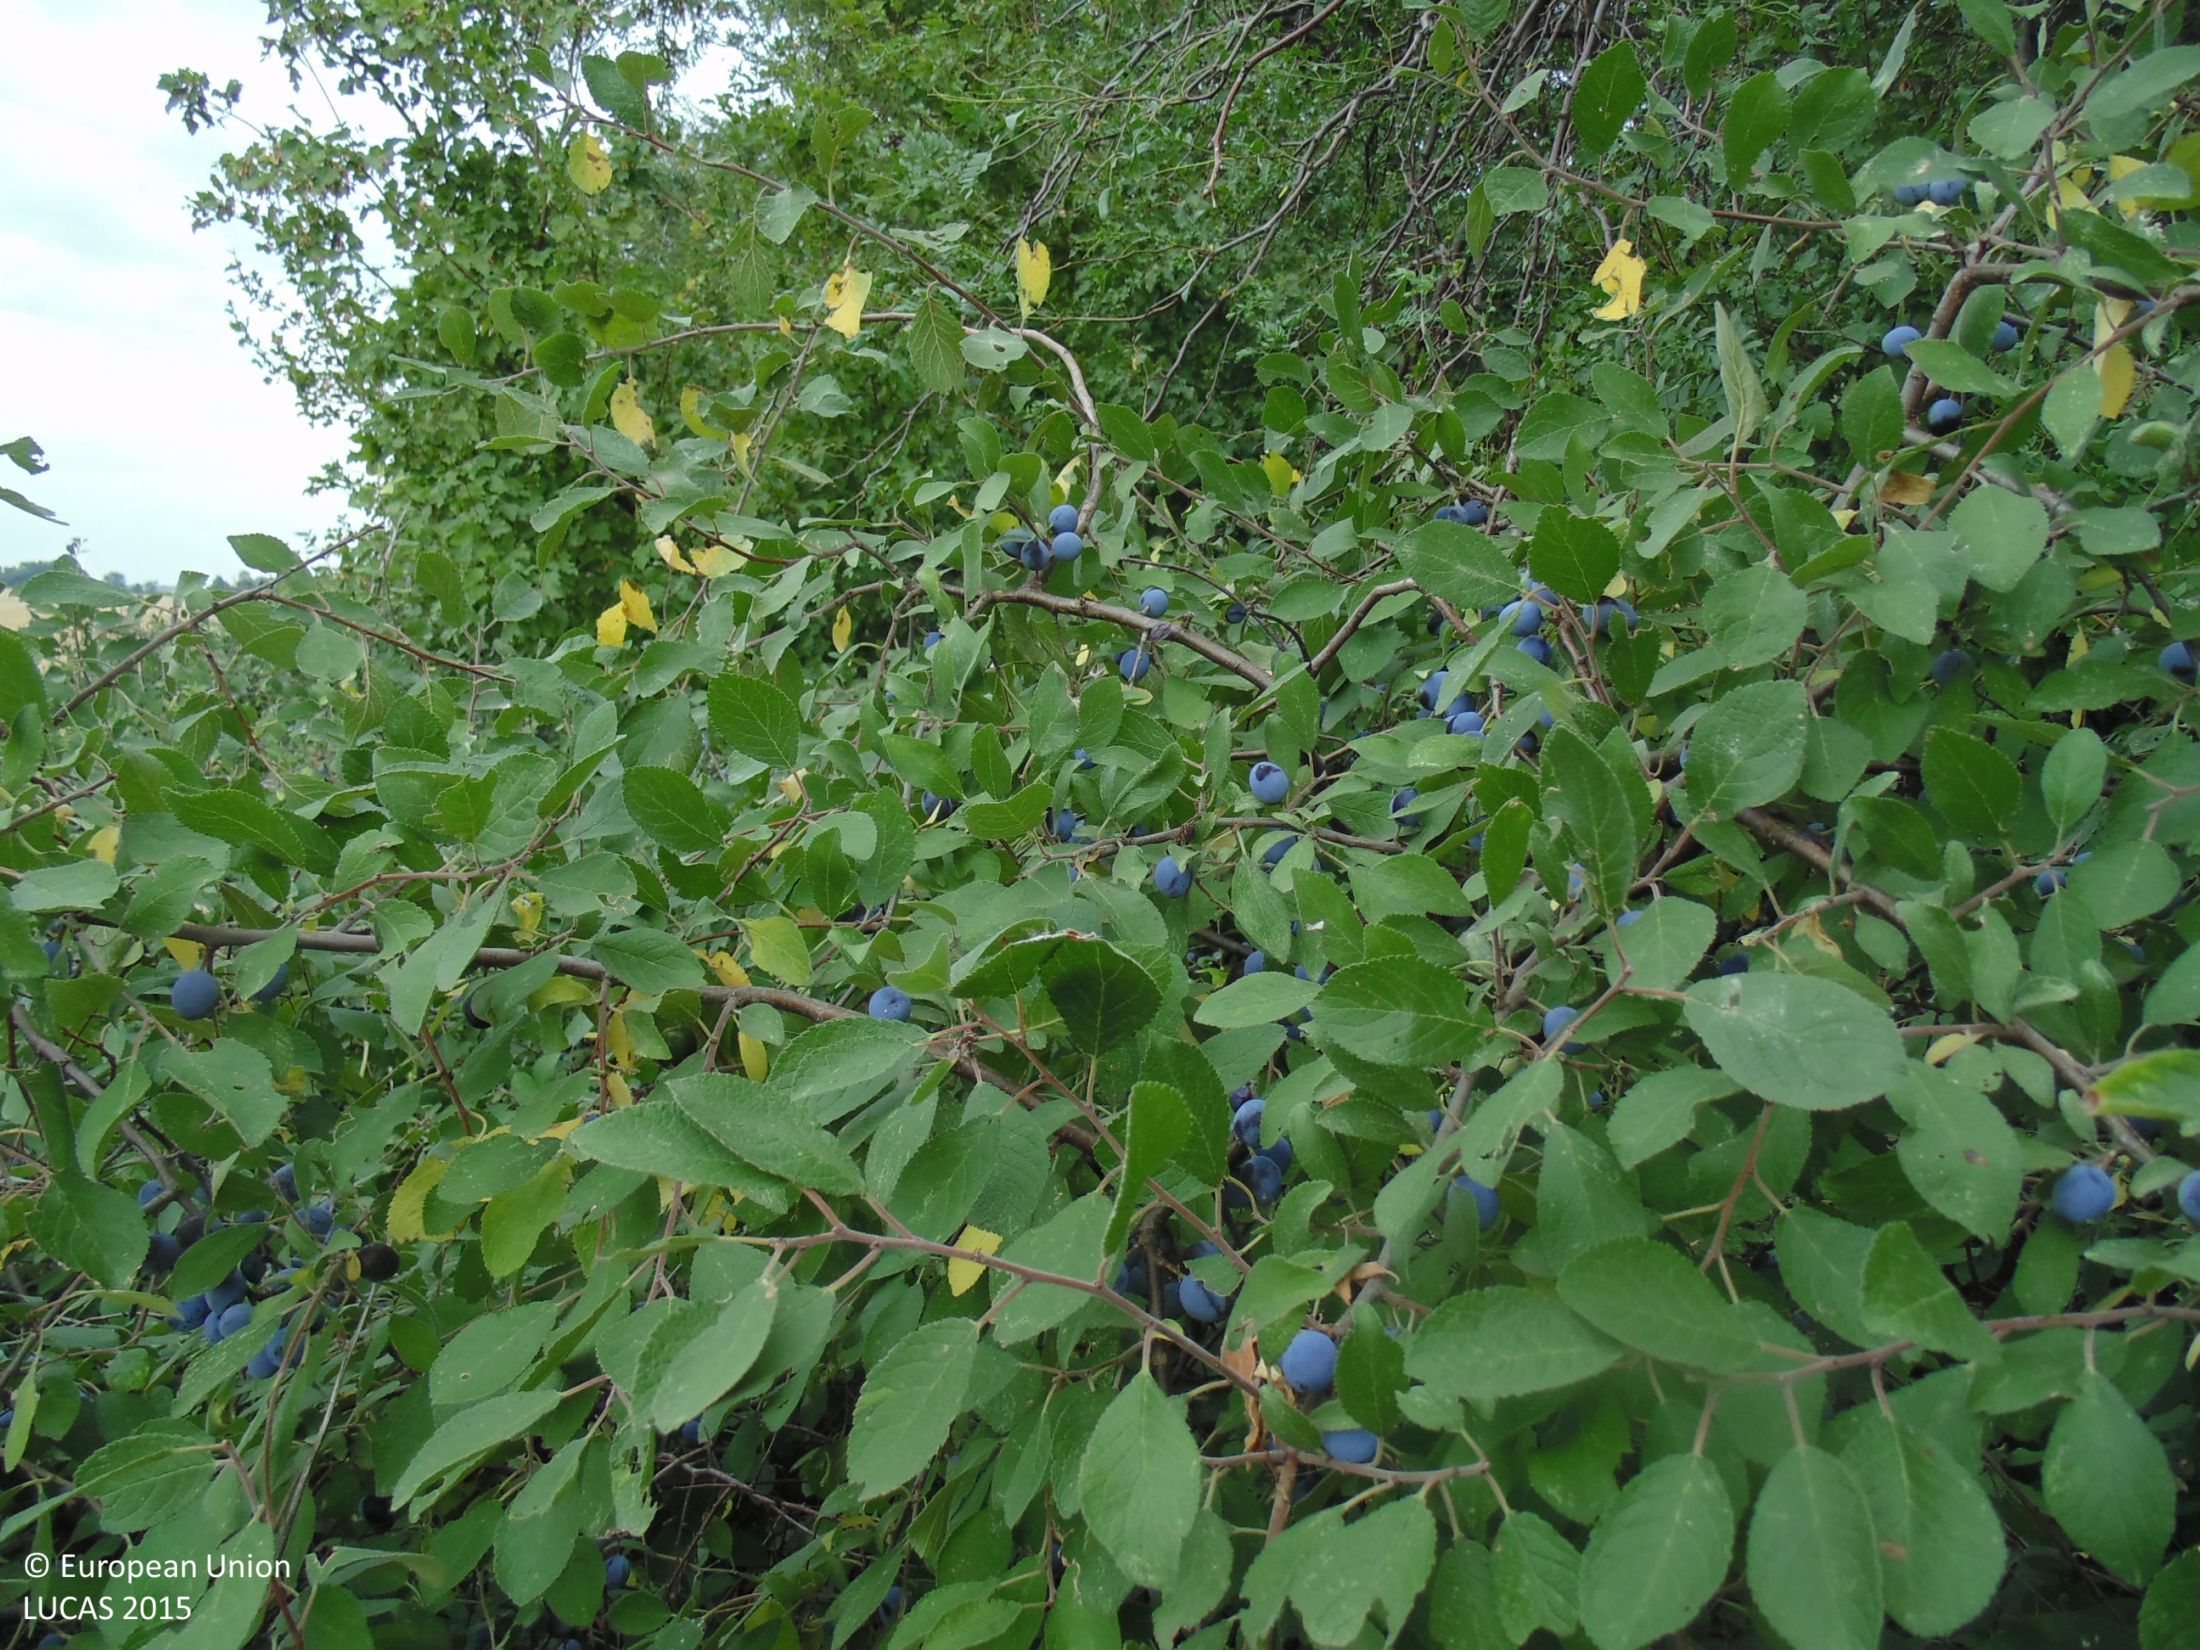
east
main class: Woodland
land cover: Broadleaved woodland
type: mesophytic deciduous forest
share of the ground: > 75 %
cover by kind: broadleaved forest trees 90 %, shrubs 10 %
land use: Forestry
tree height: > 5 m
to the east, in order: Broadleaved woodland; Grass margins; Sunflower
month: August
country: BG
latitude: 43.5784
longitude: 28.4765
